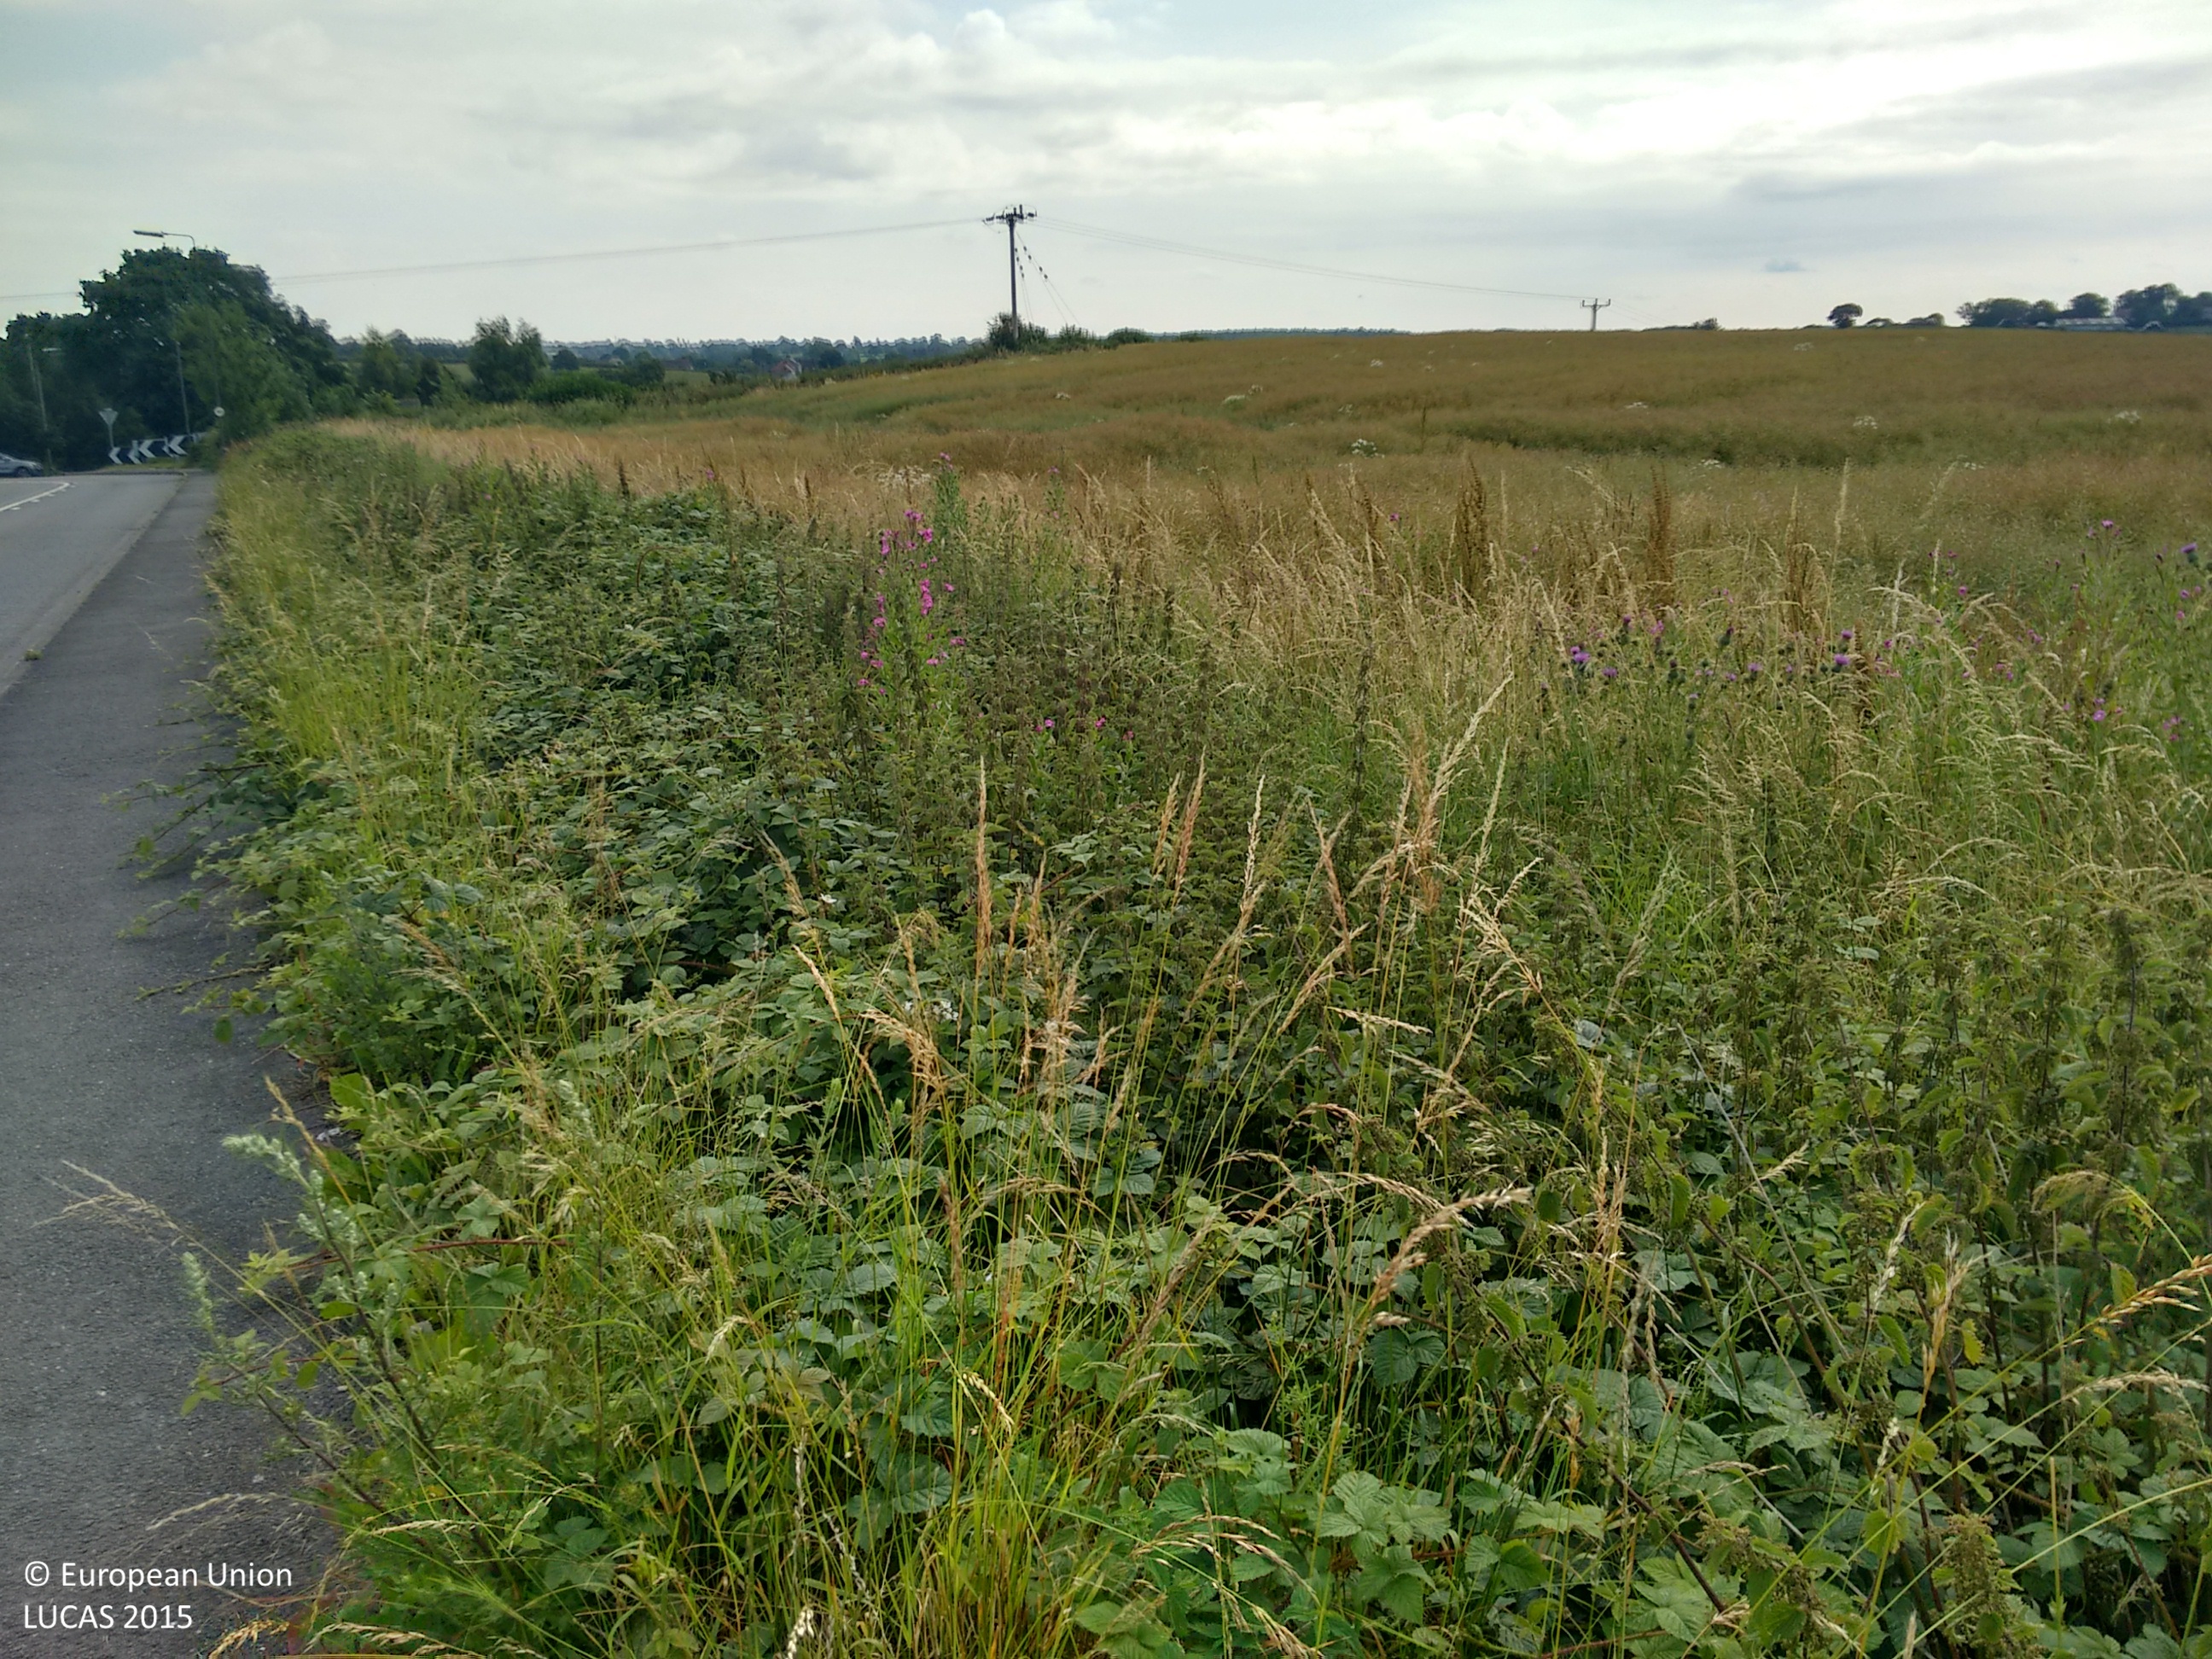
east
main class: Cropland
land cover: Rape and turnip rape
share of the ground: > 75 %
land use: Agriculture (excluding fallow land and kitchen gardens)
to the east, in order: Rape and turnip rape; Grass margins; Electric lines; Managed hedges; Arable land (only in case pi)
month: July
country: GB
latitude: 53.0376
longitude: -1.4588
